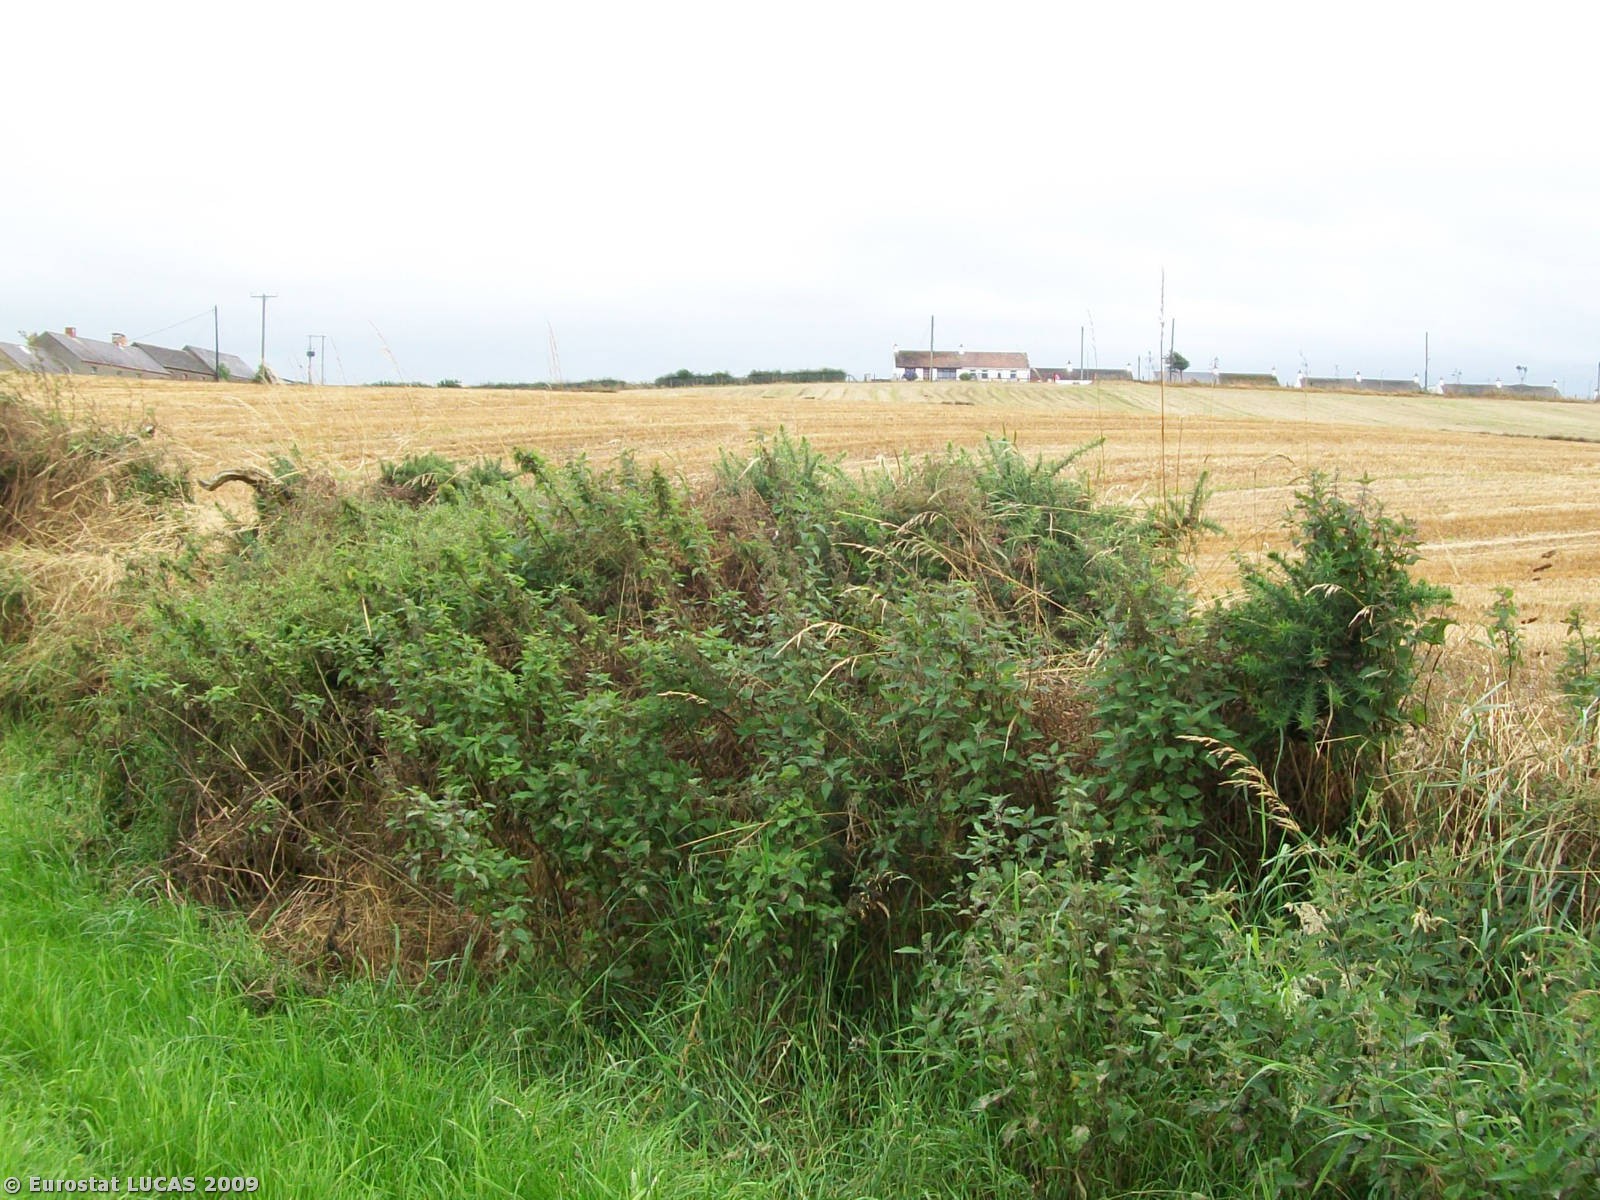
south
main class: Grassland
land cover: Grassland without tree/shrub cover
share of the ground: > 75 %
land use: Agriculture (excluding fallow land and kitchen gardens)
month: August
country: GB
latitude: 54.5200
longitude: -5.9435
